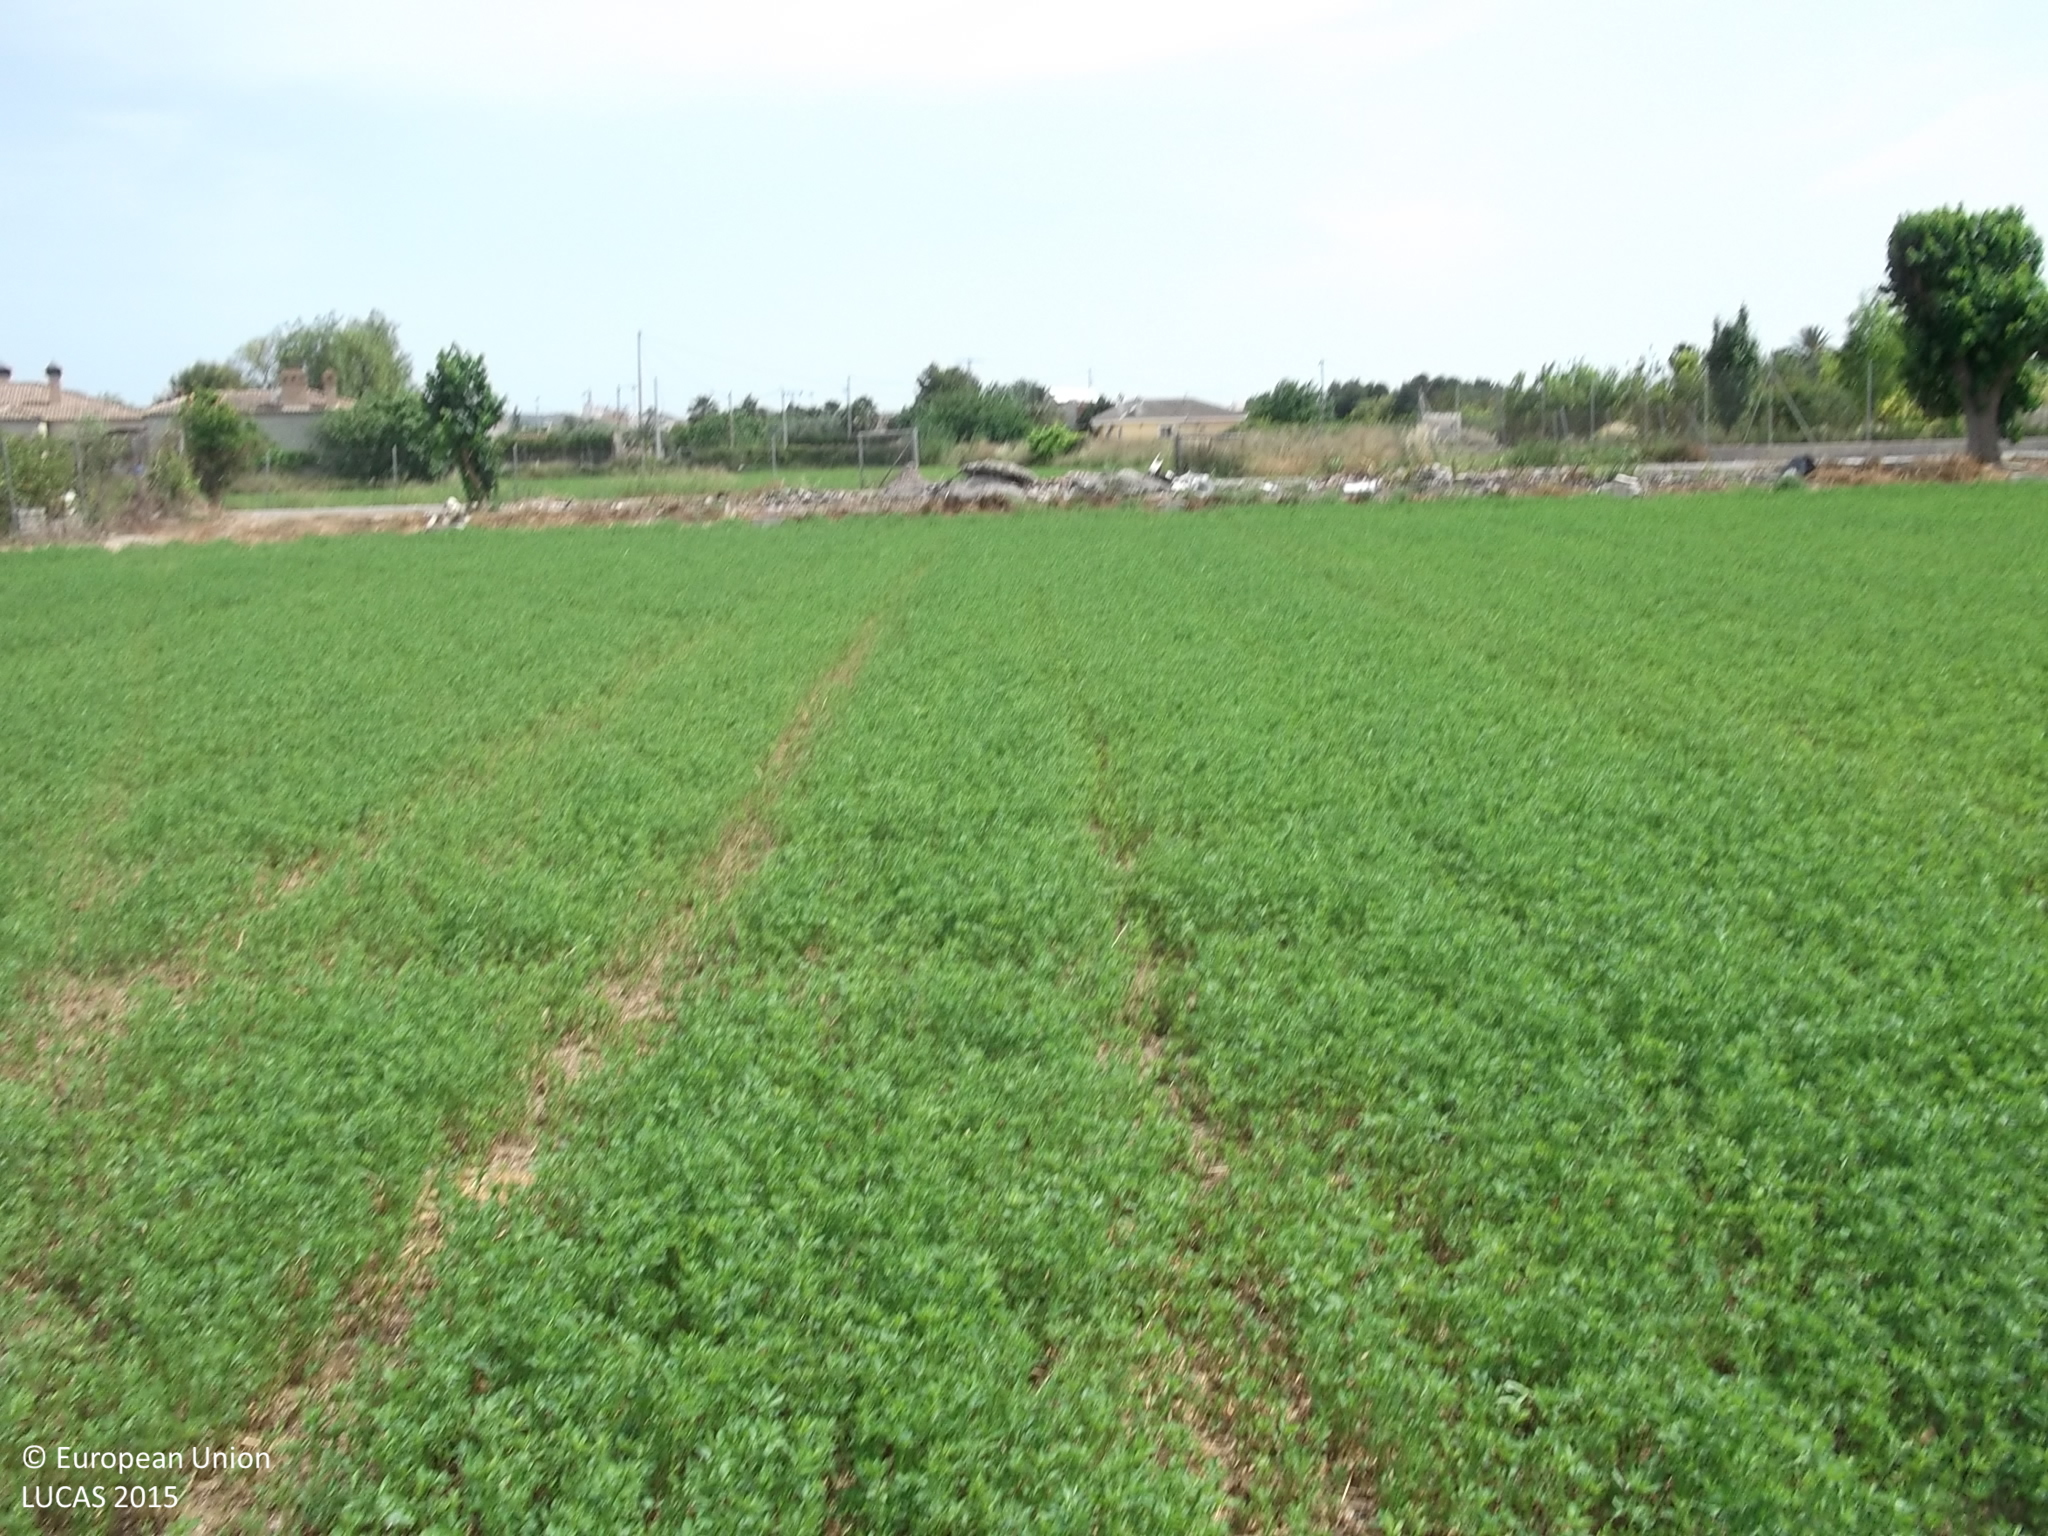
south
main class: Cropland
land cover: Lucerne
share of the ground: > 75 %
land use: Agriculture (excluding fallow land and kitchen gardens)
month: May
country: ES
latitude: 38.1115
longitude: -0.8534
